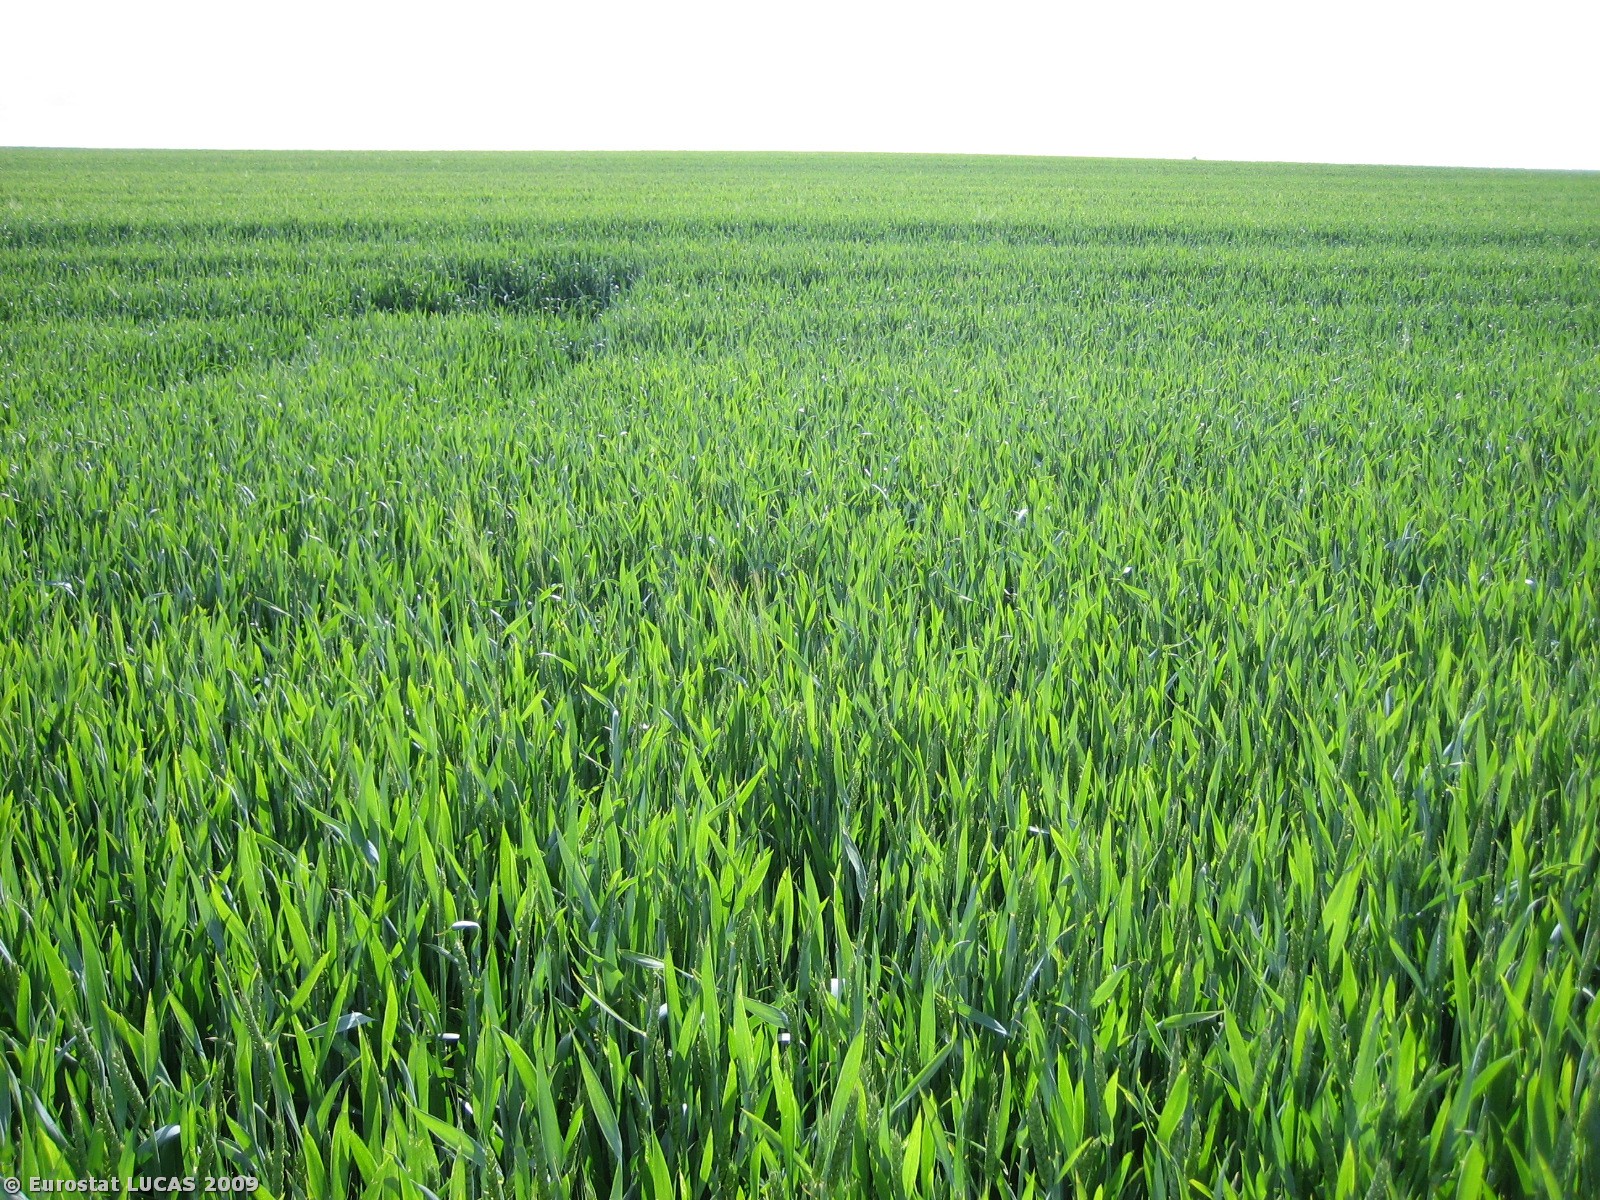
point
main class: Cropland
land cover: Common wheat
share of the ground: > 75 %
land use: Agriculture (excluding fallow land and kitchen gardens)
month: June
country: DK
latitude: 56.1515
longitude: 9.7267
